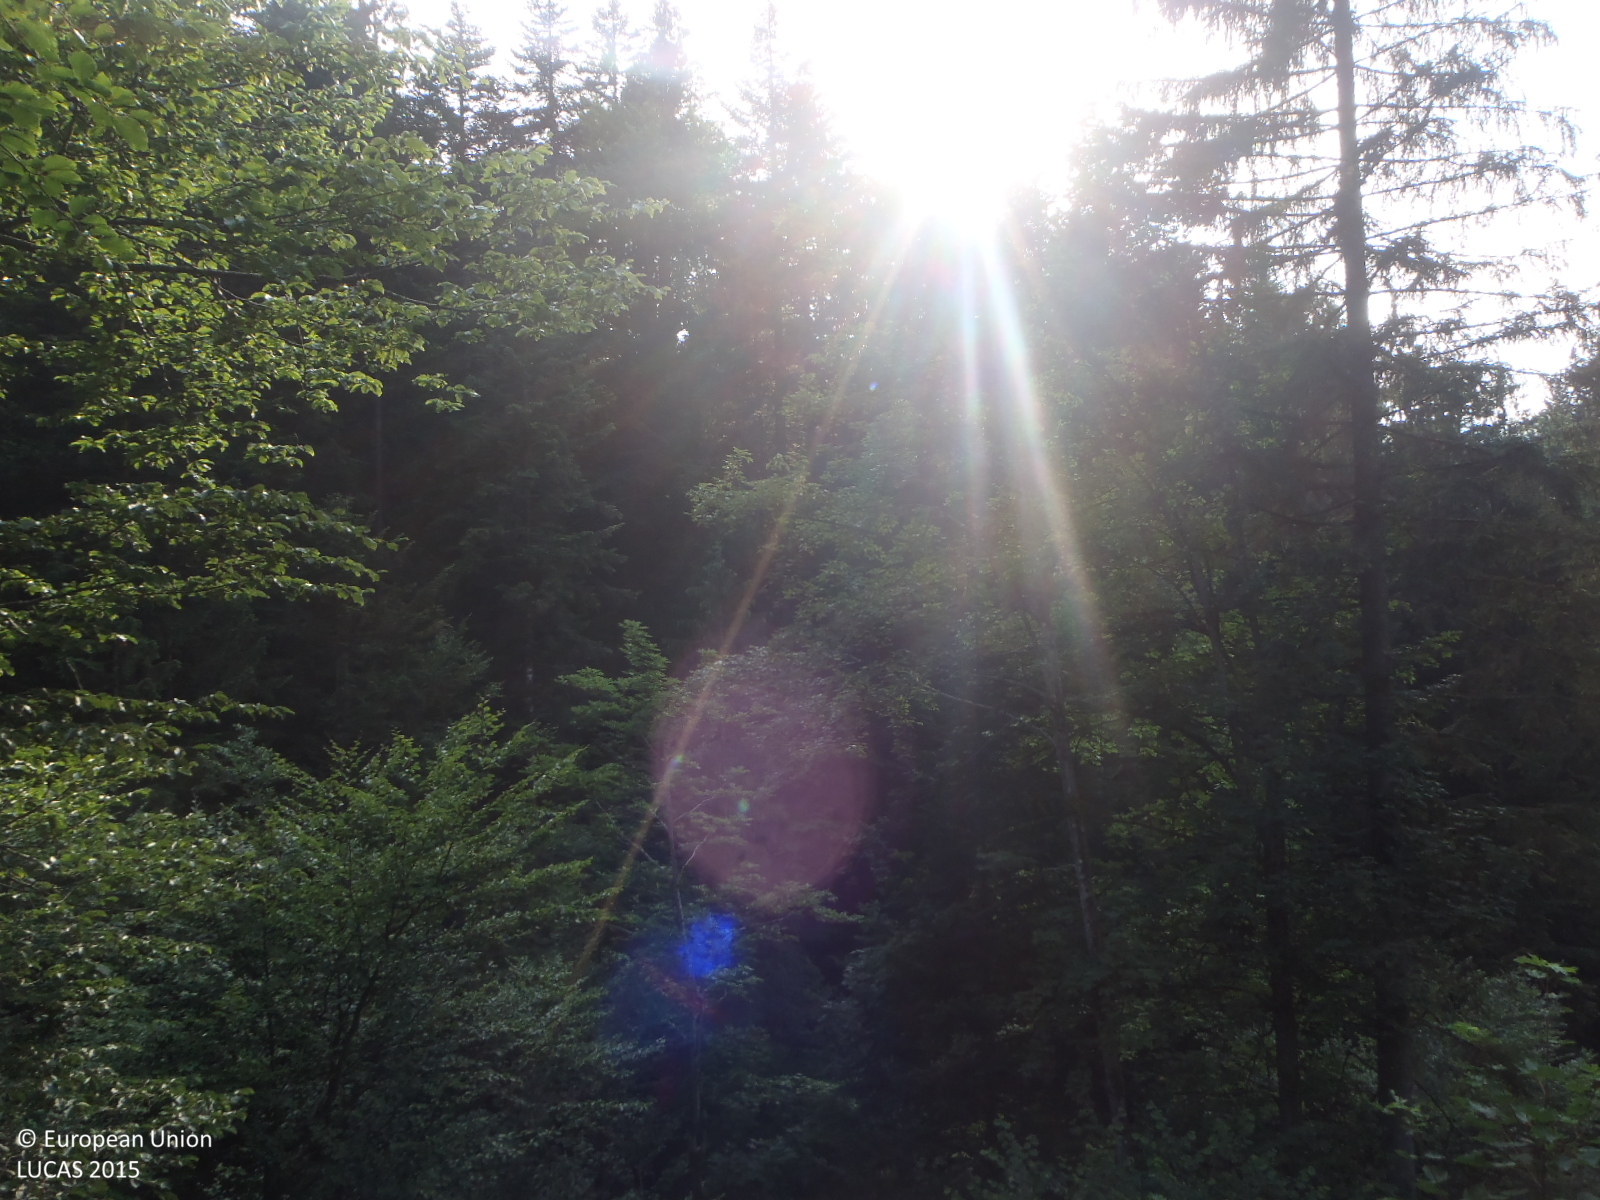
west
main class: Woodland
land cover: Other mixed woodland
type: alpine coniferous forest
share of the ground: > 75 %
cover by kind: coniferous forest trees 35 %, broadleaved forest trees 30 %, shrubs 20 %, herbaceous plants 15 %
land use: Forestry
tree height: > 5 m
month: July
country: AT
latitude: 47.5126
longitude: 12.4283
